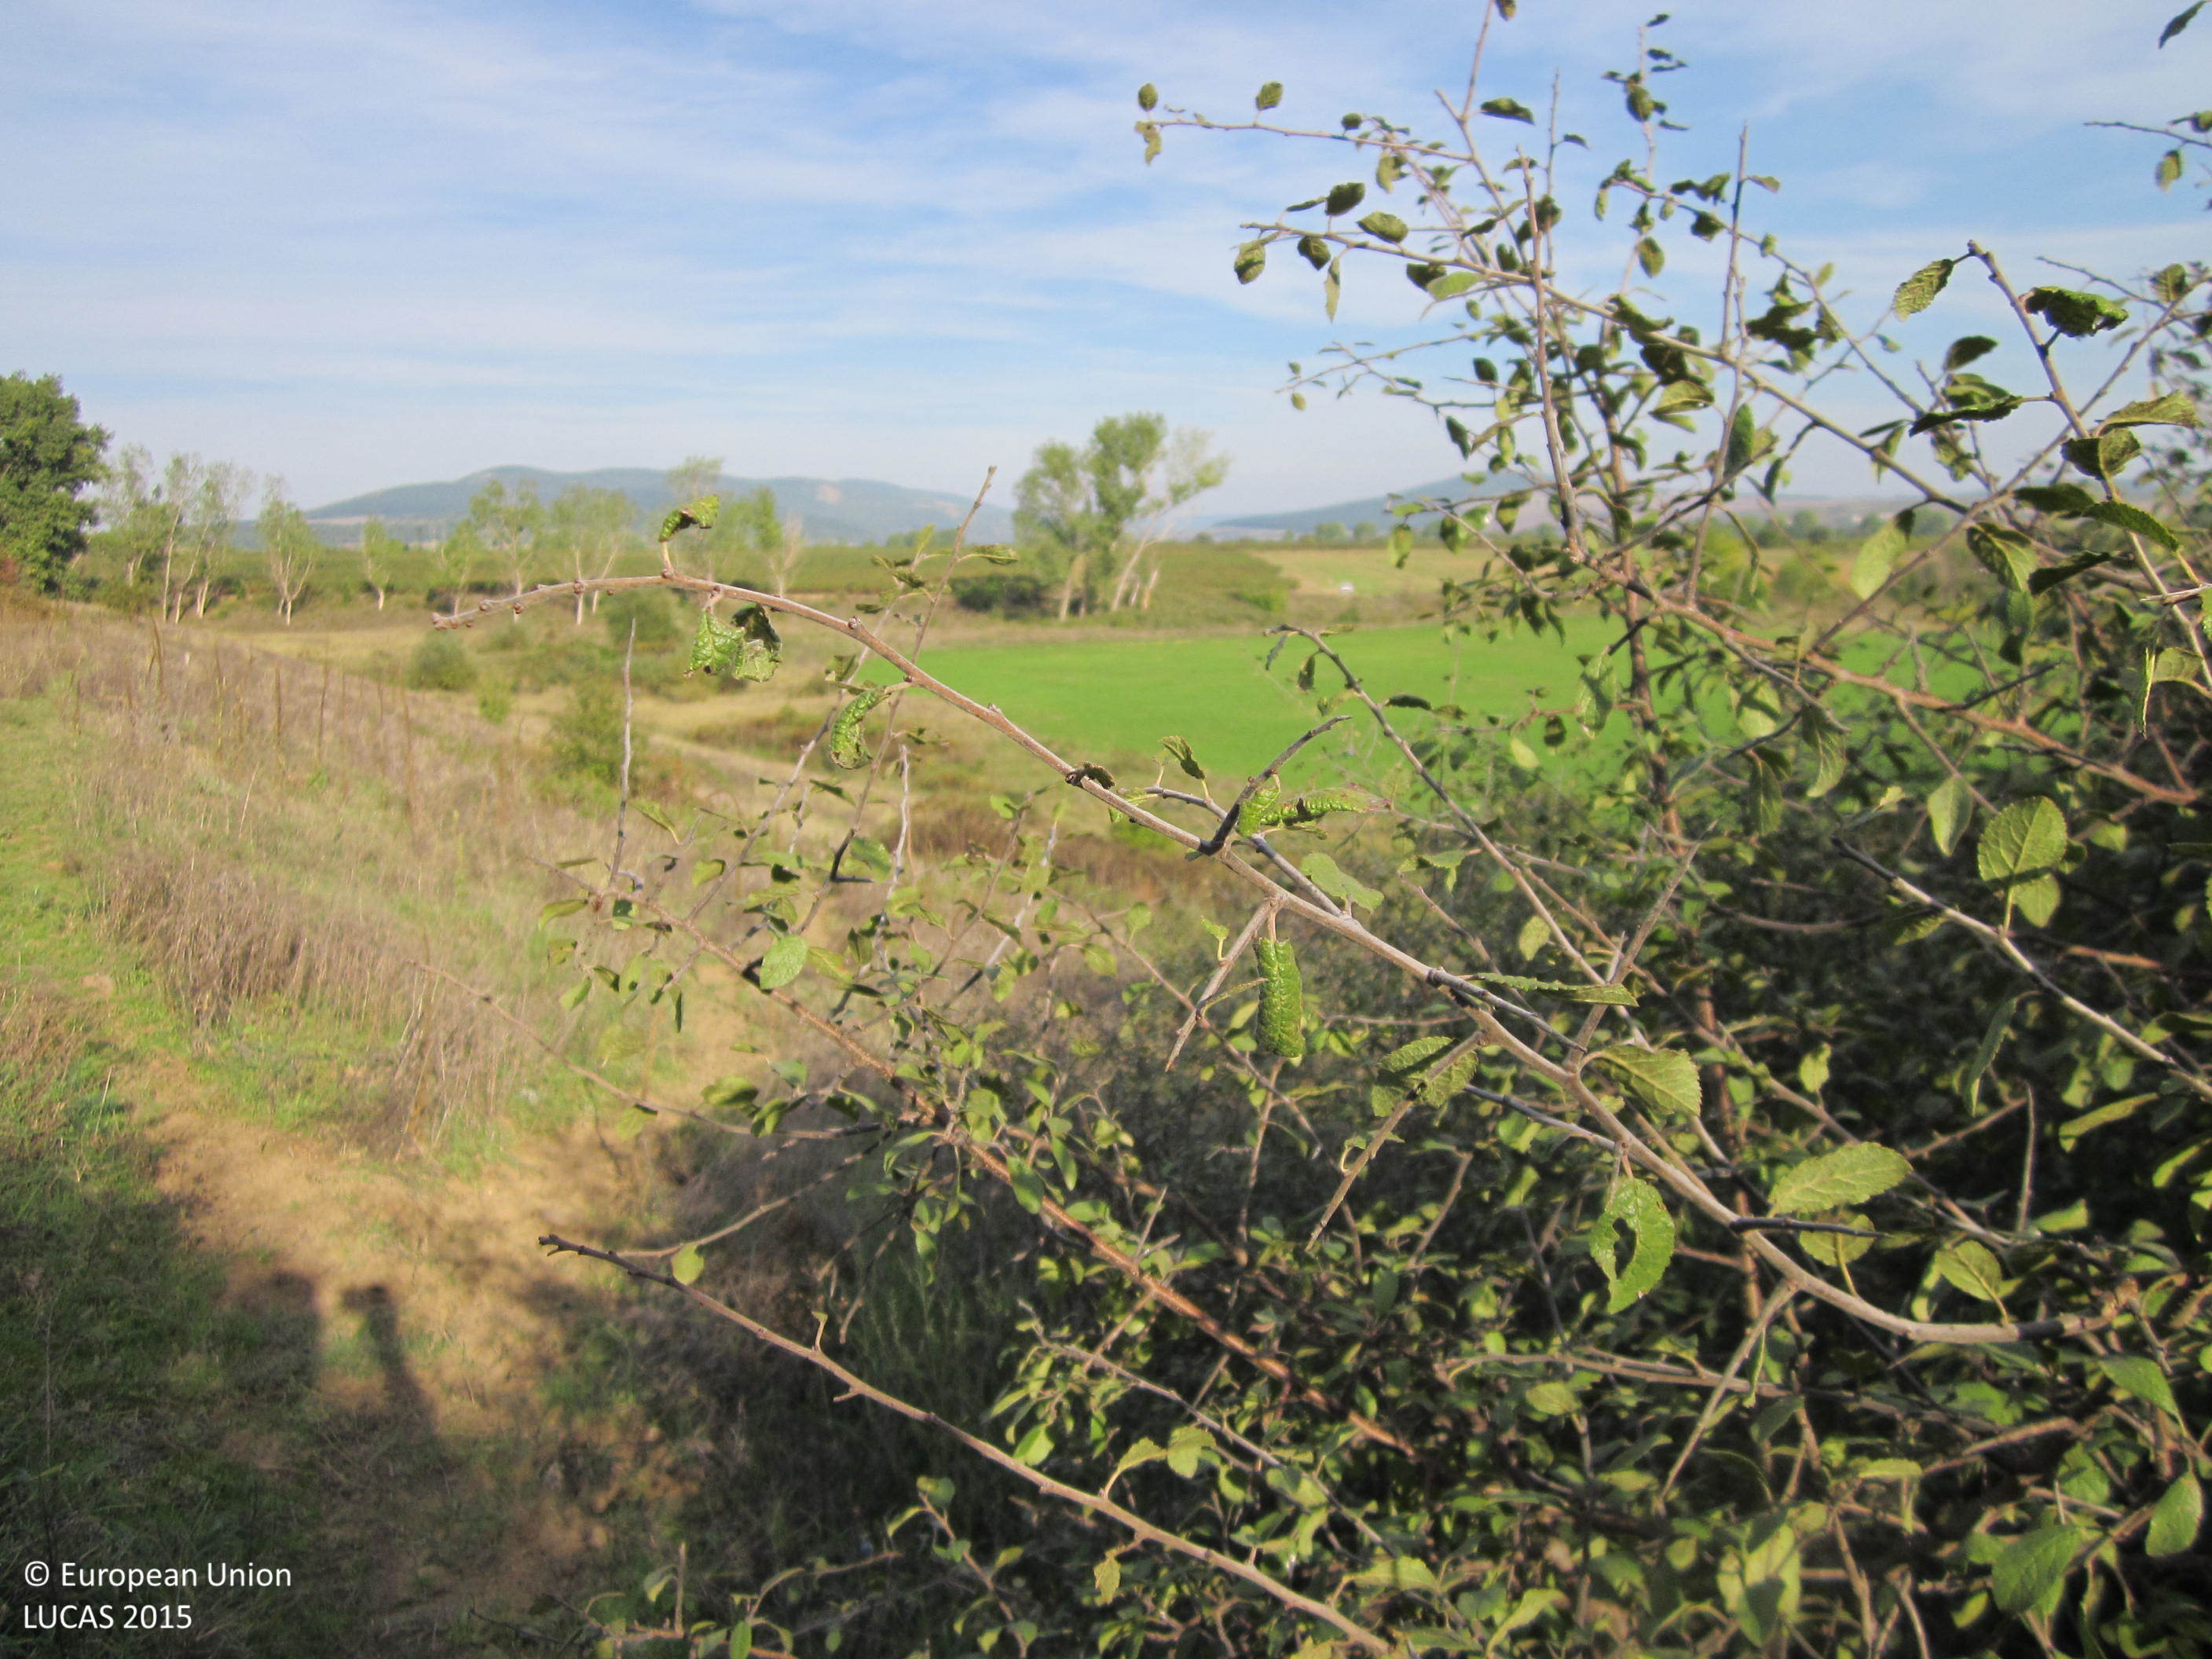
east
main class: Shrubland
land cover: Shrubland with sparse tree cover
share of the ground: 50 - 75 %
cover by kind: shrubs 55 %, herbaceous plants 40 %, broadleaved forest trees 5 %
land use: Semi-natural and natural areas not in use
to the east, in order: Shrubland with sparse tree cover; Grassland with sparse tree/shrub cover; Grassland without tree/shrub cover; Tracks; Lucerne; Grassland with sparse tree/shrub cover; Tracks; Grass margins; Vineyards
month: October
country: BG
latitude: 42.7786
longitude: 26.8374
